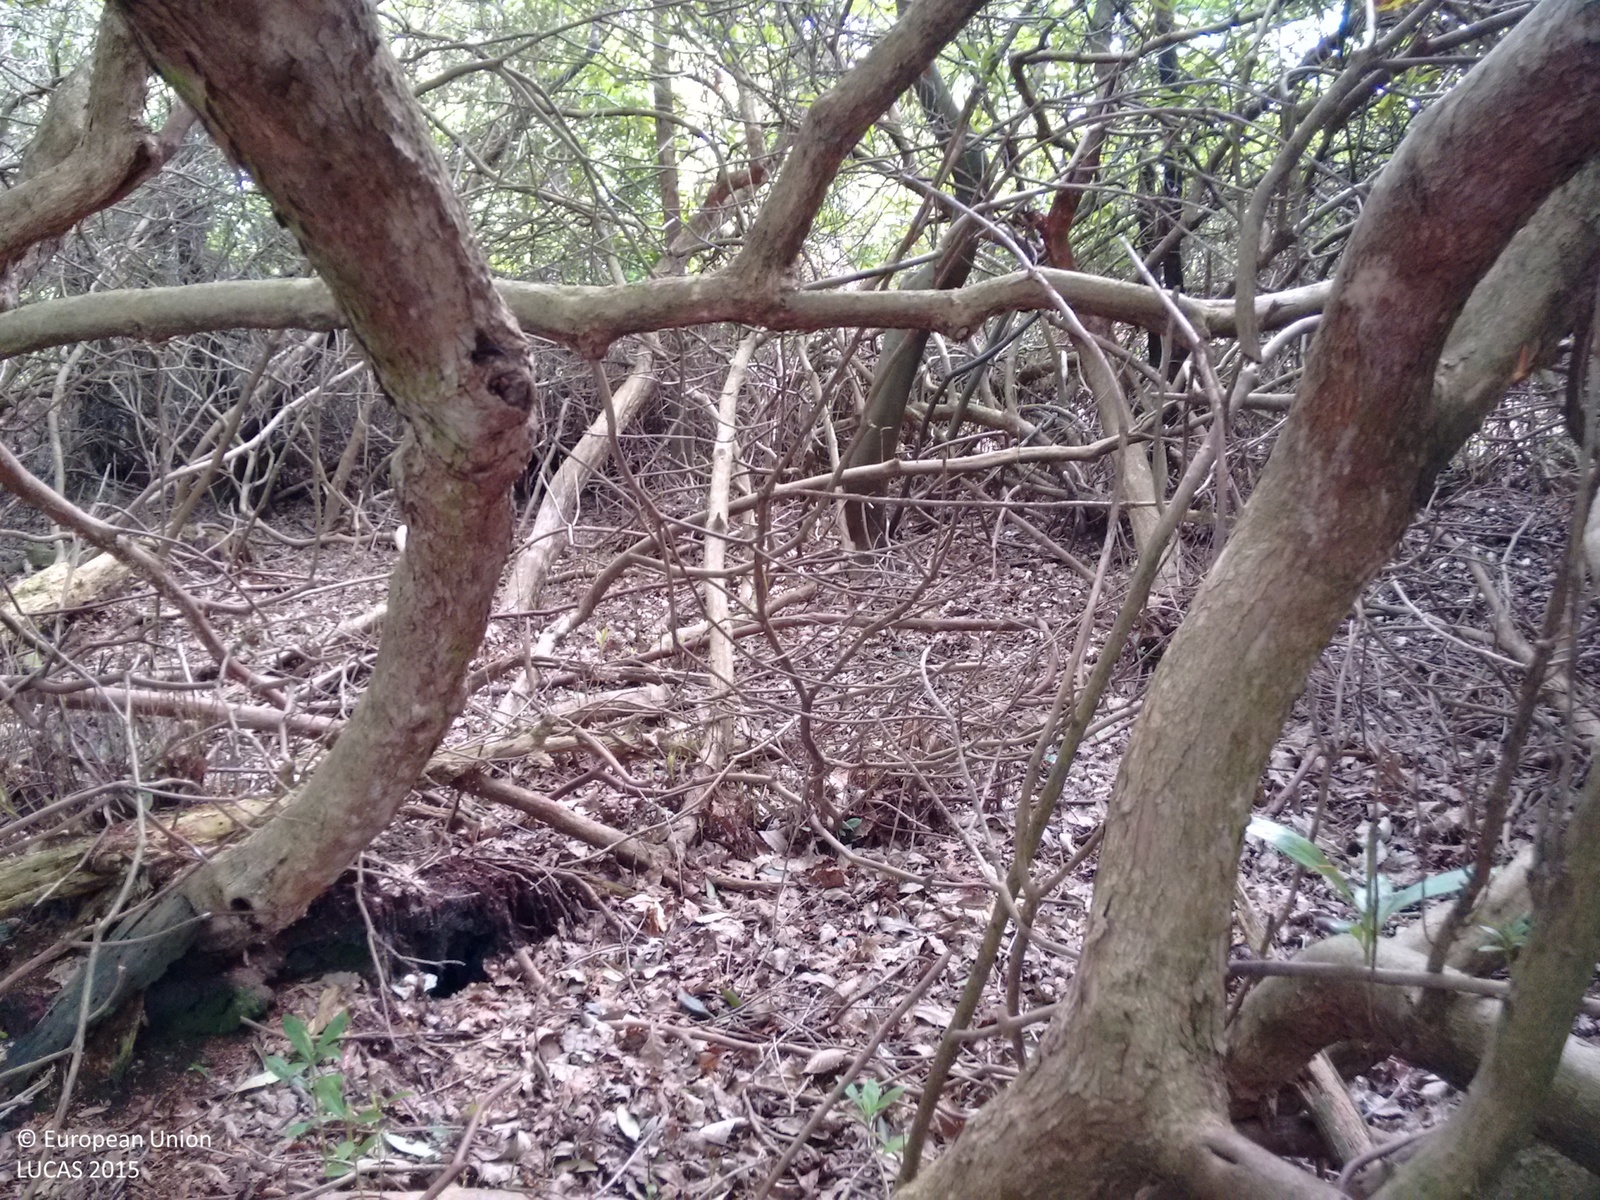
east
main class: Woodland
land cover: Broadleaved woodland
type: hemiboreal forest and nemoral coniferous forest and mixed broadleaved-coniferous forest
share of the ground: > 75 %
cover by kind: broadleaved forest trees 65 %, shrubs 15 %, coniferous forest trees 10 %, herbaceous plants 10 %
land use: Semi-natural and natural areas not in use
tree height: > 5 m
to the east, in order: Broadleaved woodland; Other mixed woodland; Fences; Broadleaved woodland; Electric lines; Broadleaved woodland; Shrubland with sparse tree cover; Broadleaved woodland; Tracks; Broadleaved woodland; Artificial constructions in urban areas
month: May
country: GB
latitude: 50.6971
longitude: -2.1365
